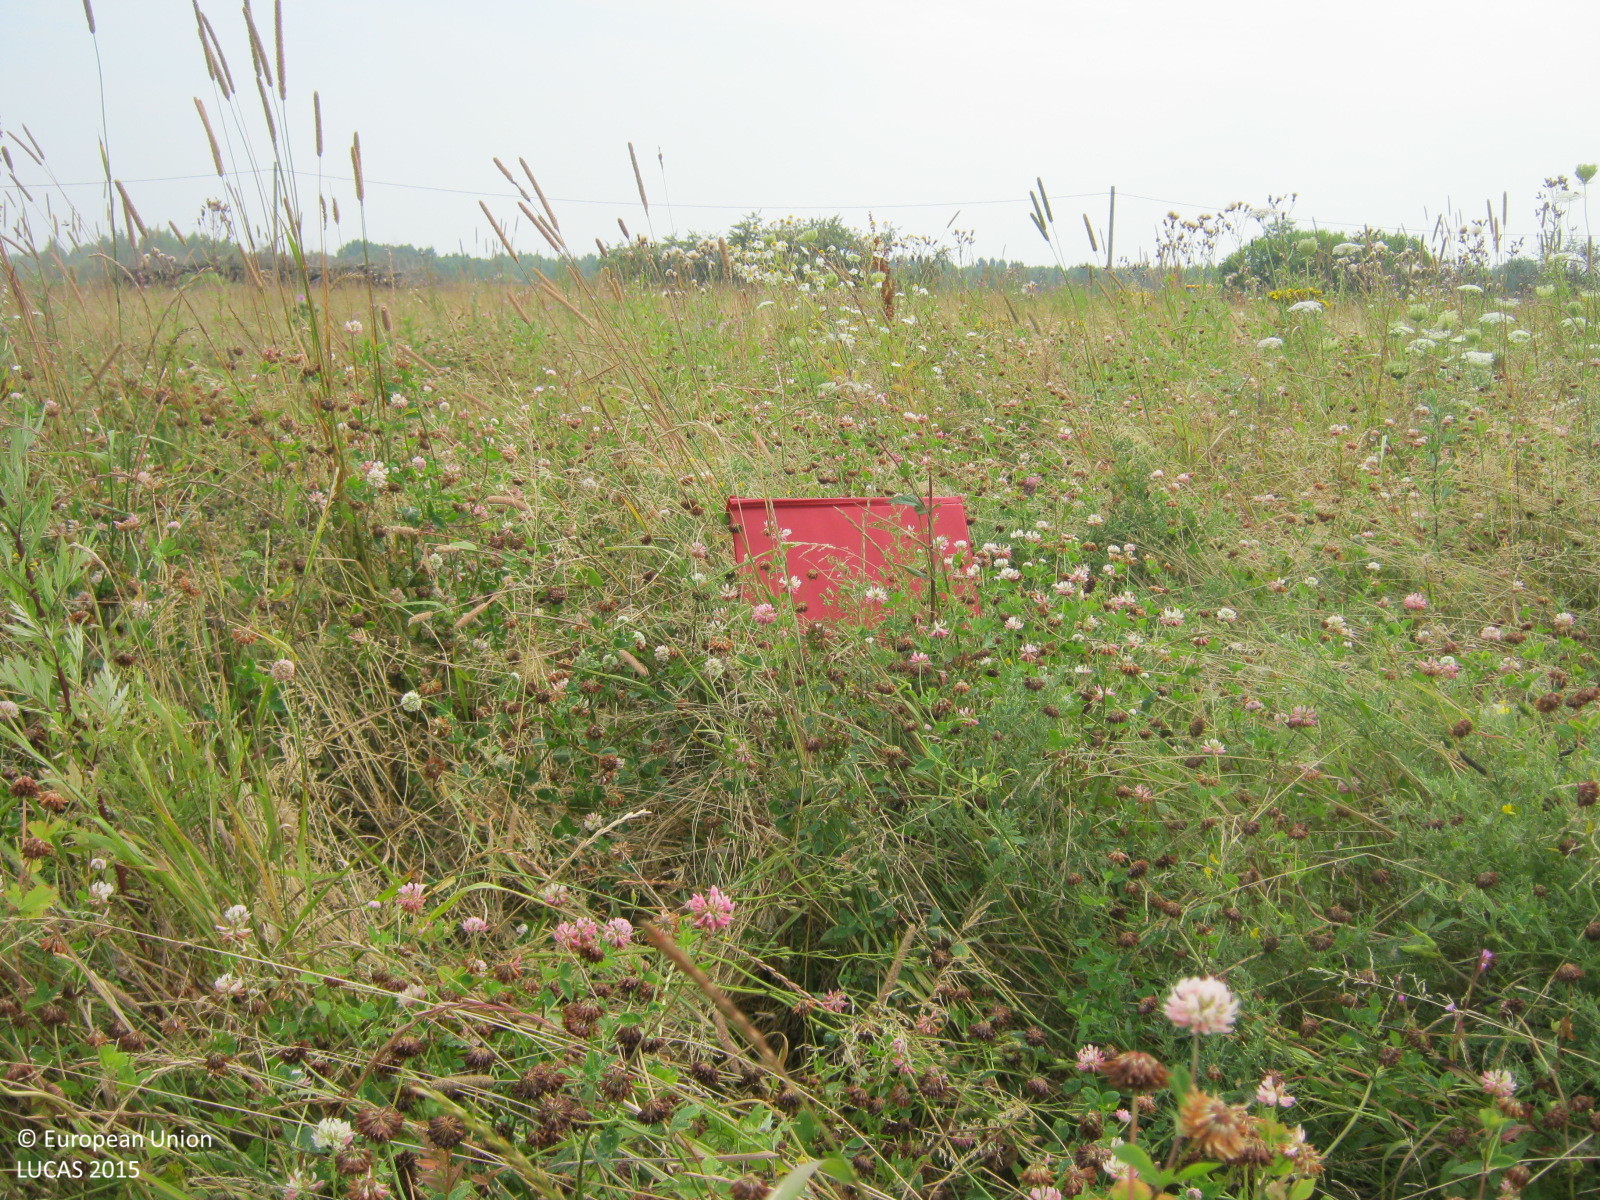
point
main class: Grassland
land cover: Spontaneously vegetated surfaces
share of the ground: > 75 %
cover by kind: herbaceous plants 100 %
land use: Fallow land
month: August
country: LV
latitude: 57.4135
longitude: 24.4576
